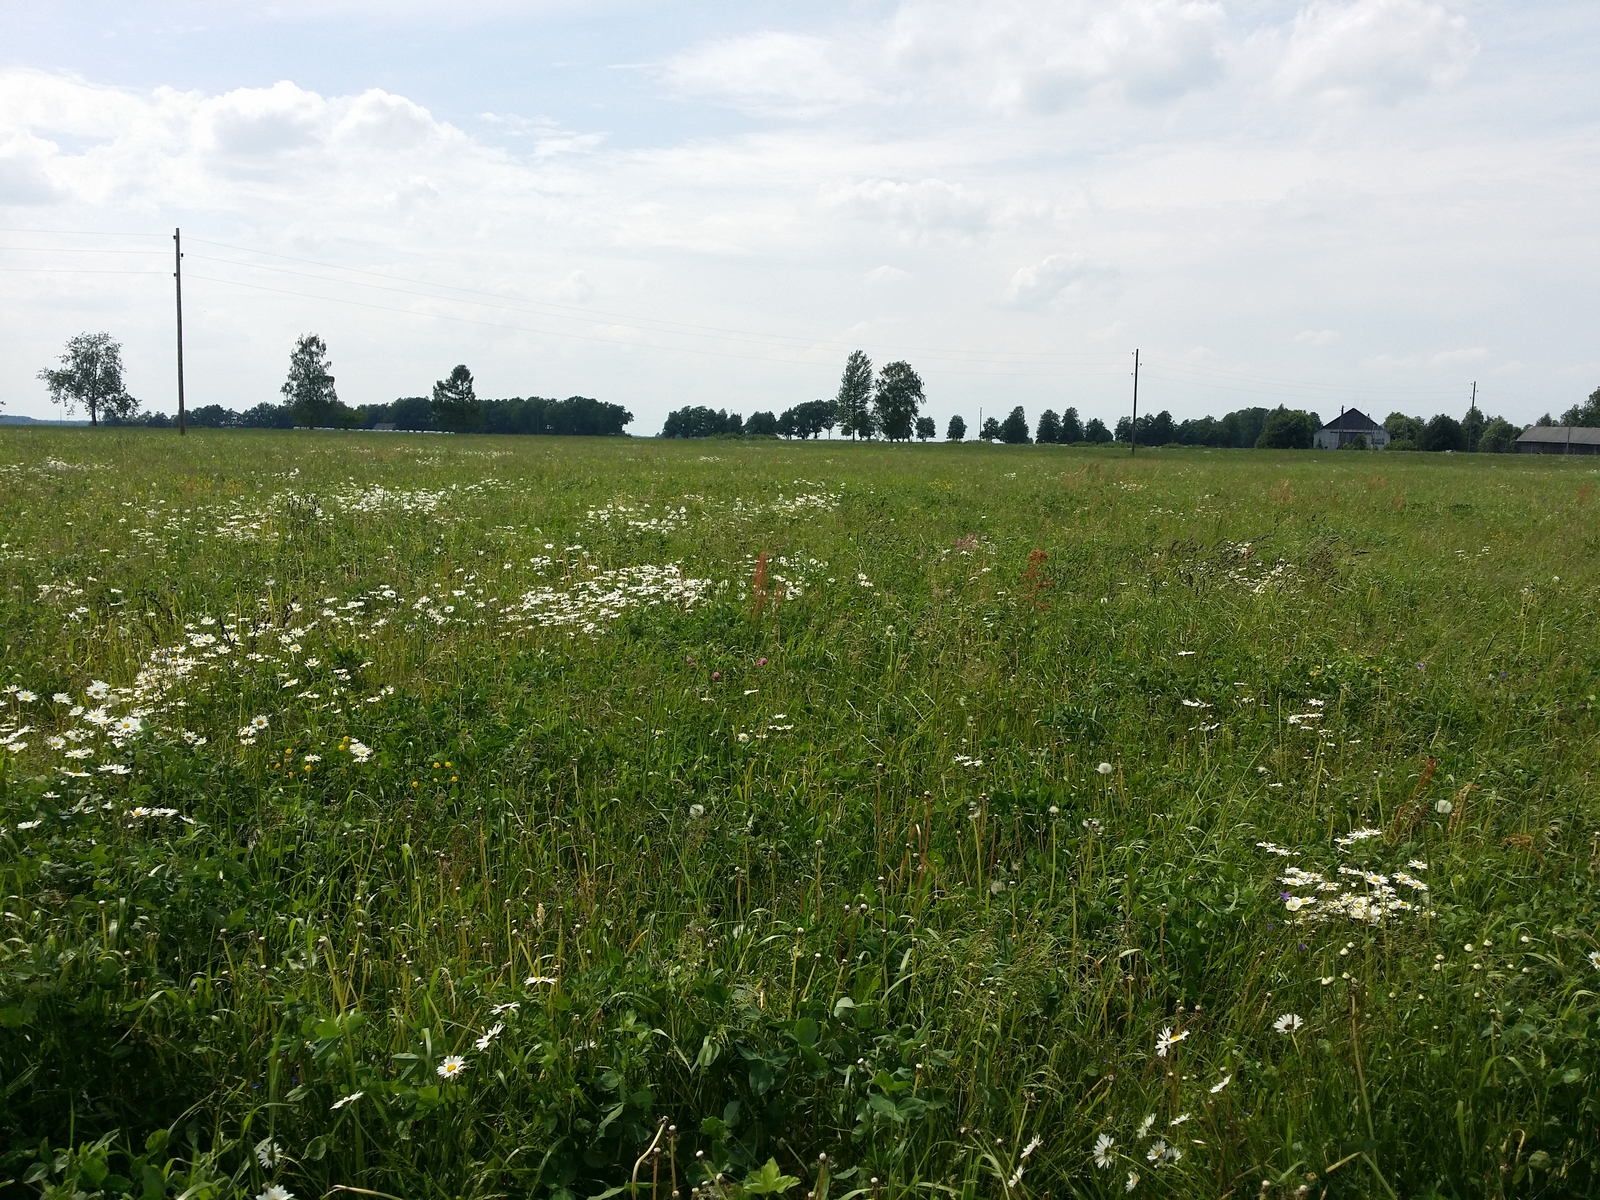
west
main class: Grassland
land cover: Grassland without tree/shrub cover
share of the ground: > 75 %
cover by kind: herbaceous plants 100 %
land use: Agriculture (excluding fallow land and kitchen gardens)
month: June
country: LV
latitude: 57.4354
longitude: 26.5868
